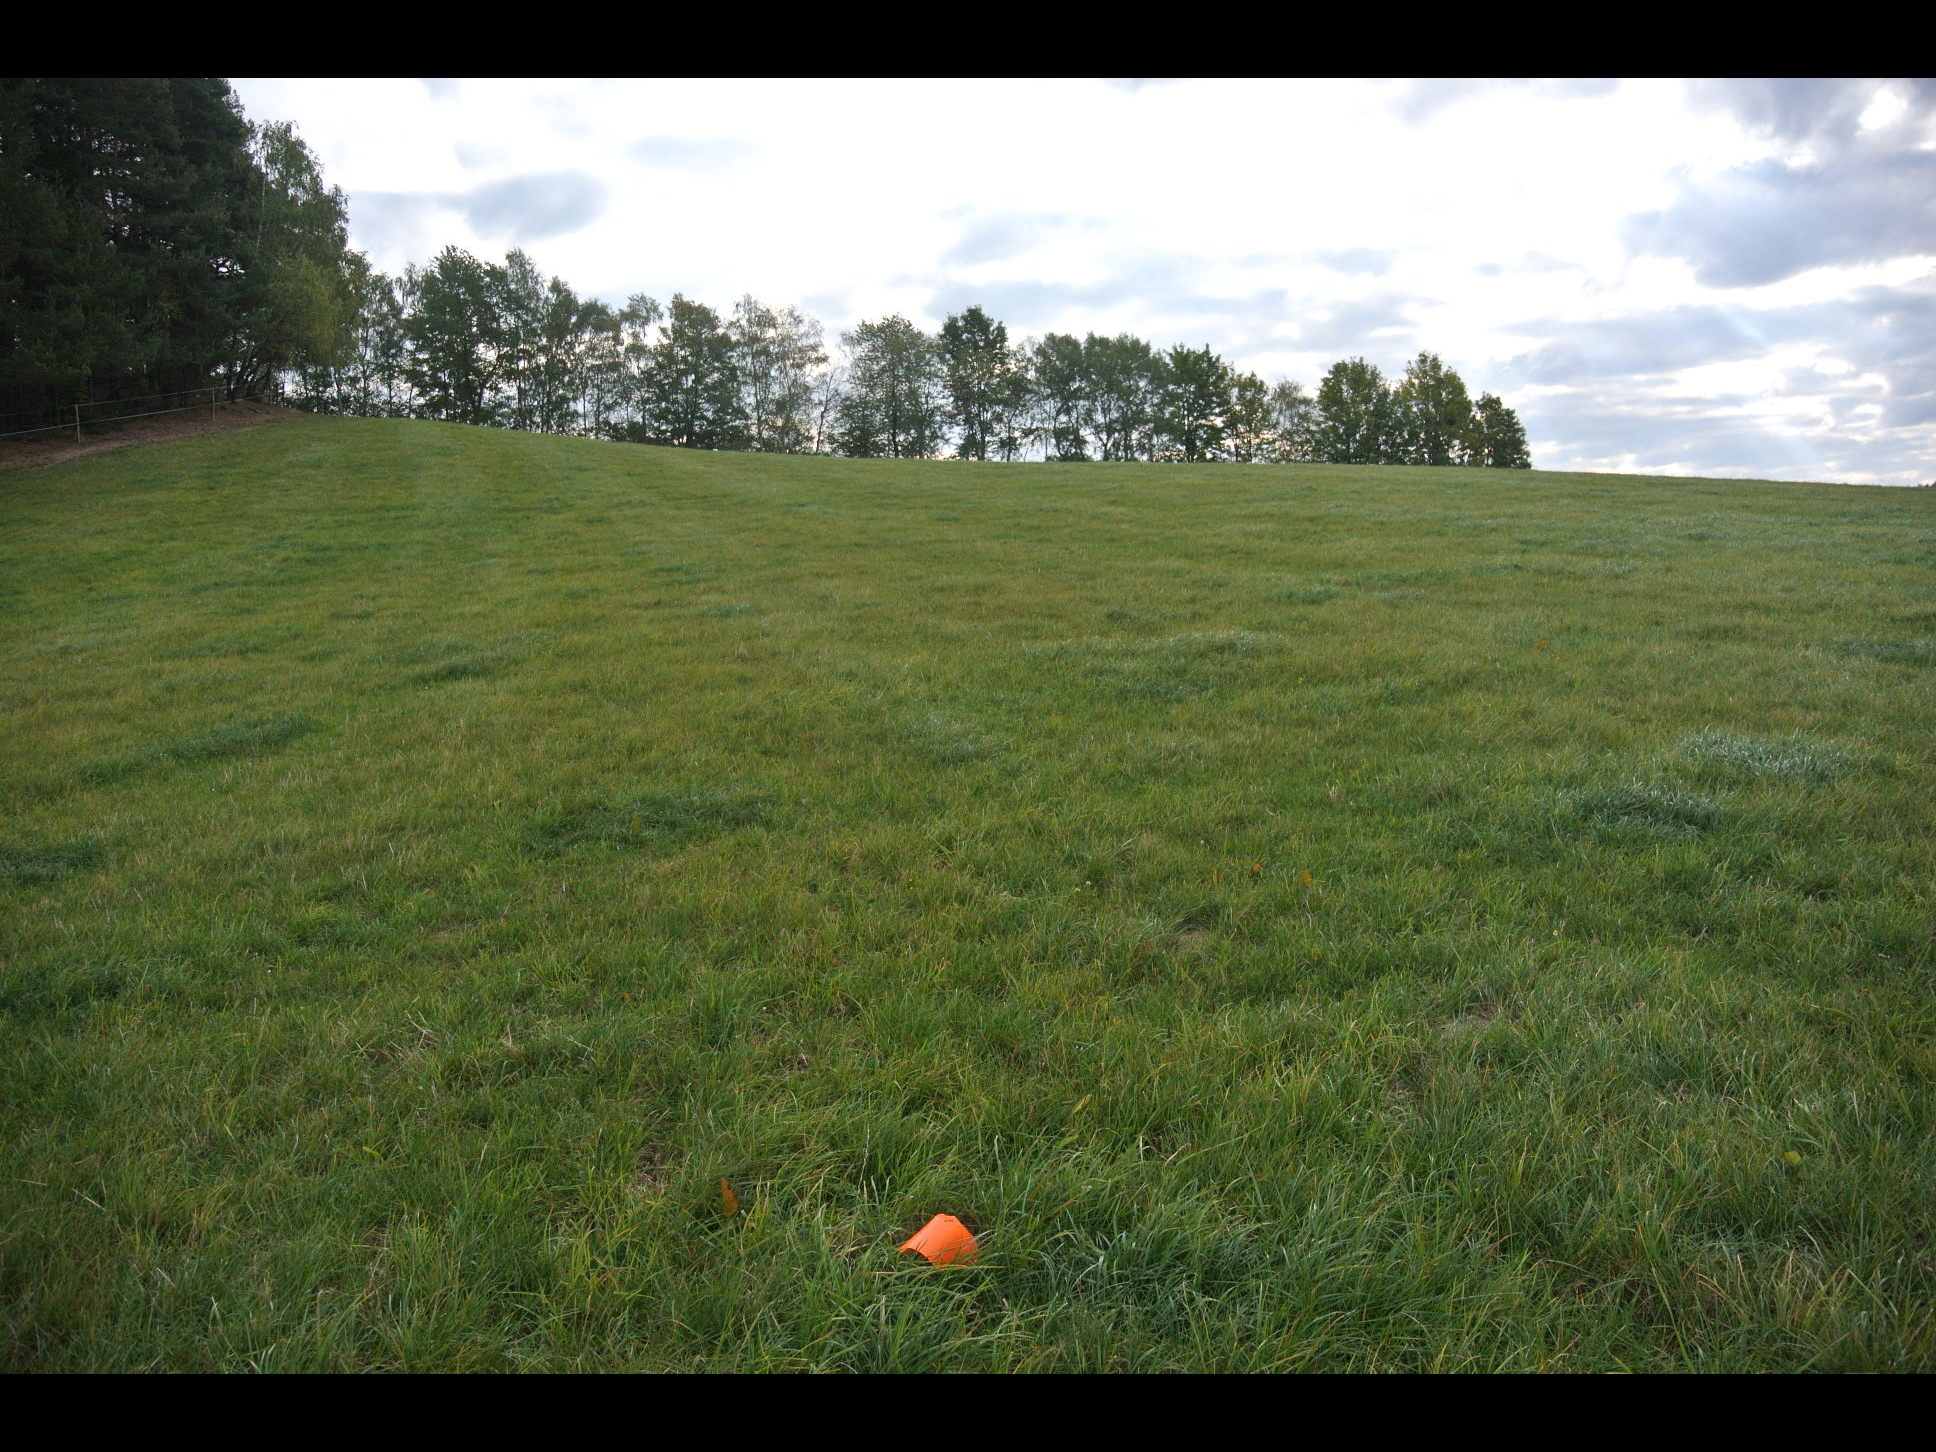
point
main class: Grassland
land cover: Grassland without tree/shrub cover
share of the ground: > 75 %
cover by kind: herbaceous plants 100 %
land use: Agriculture (excluding fallow land and kitchen gardens)
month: July
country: AT
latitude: 47.5089
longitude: 16.1768
